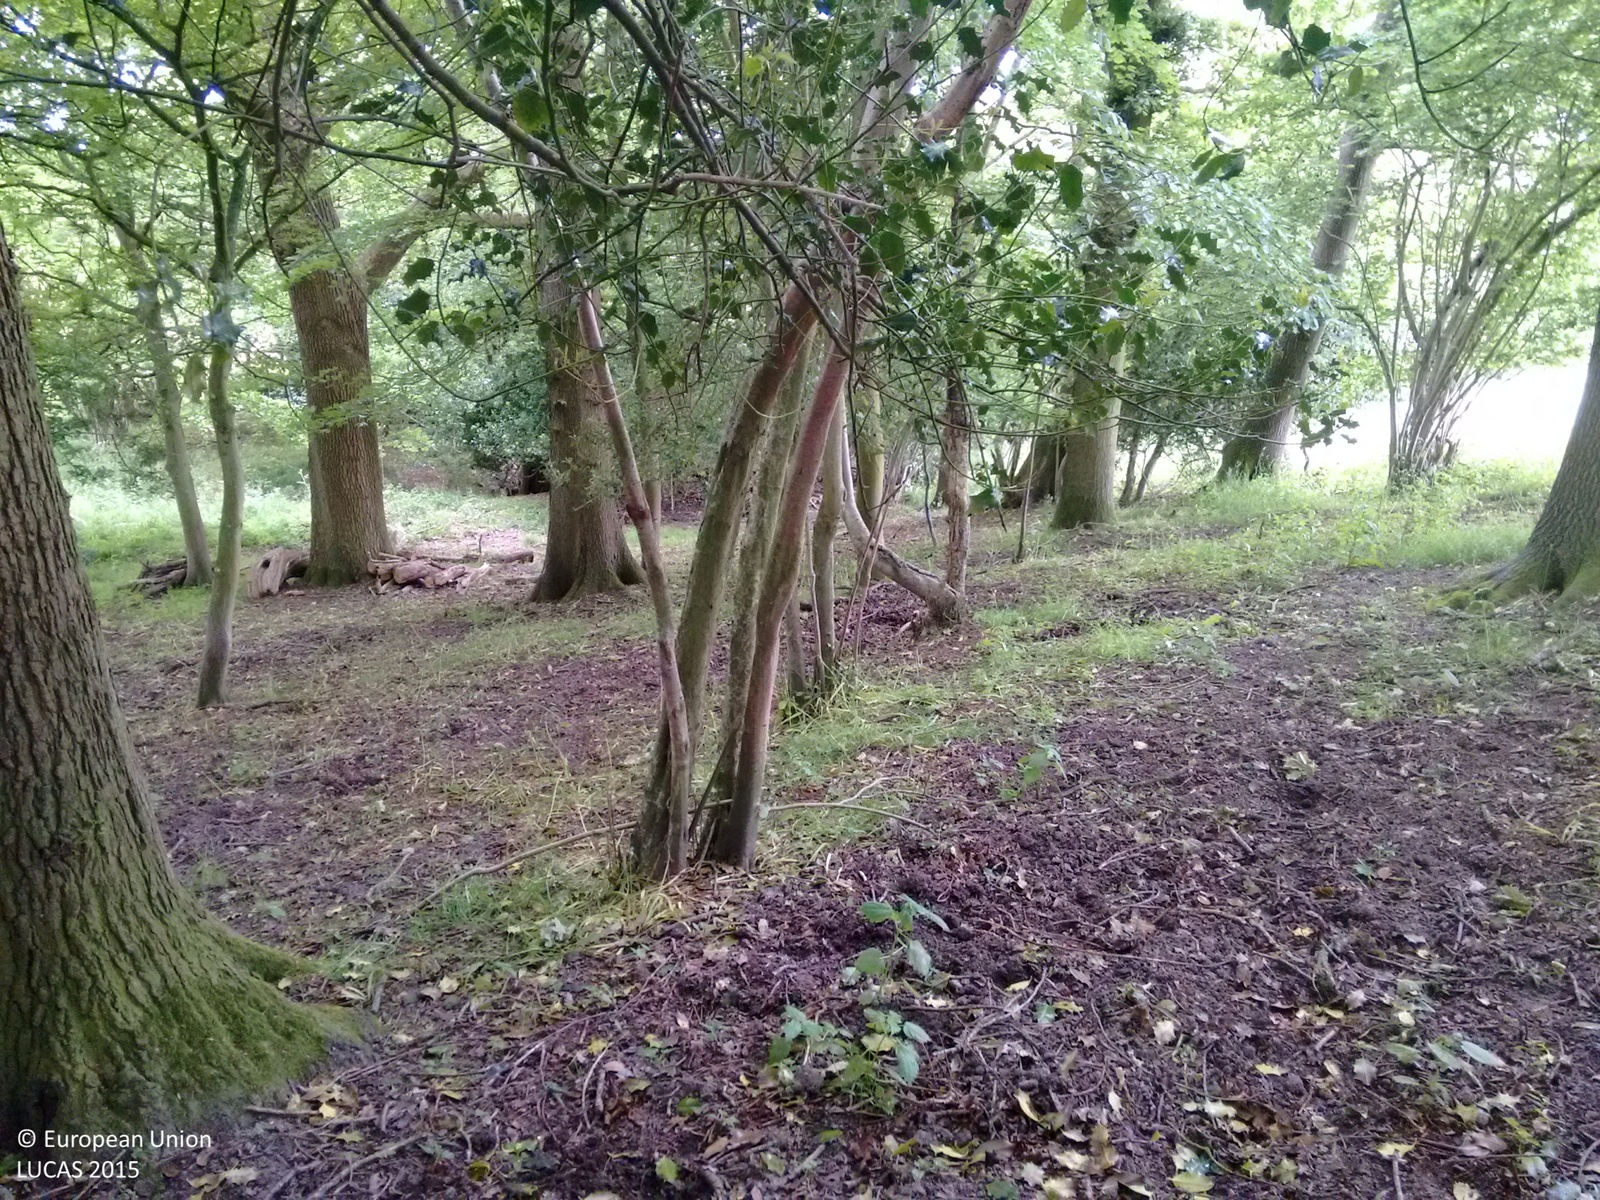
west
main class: Woodland
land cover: Broadleaved woodland
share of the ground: > 75 %
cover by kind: broadleaved forest trees 90 %, shrubs 10 %
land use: Semi-natural and natural areas not in use
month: June
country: GB
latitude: 50.9523
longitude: 0.3622
